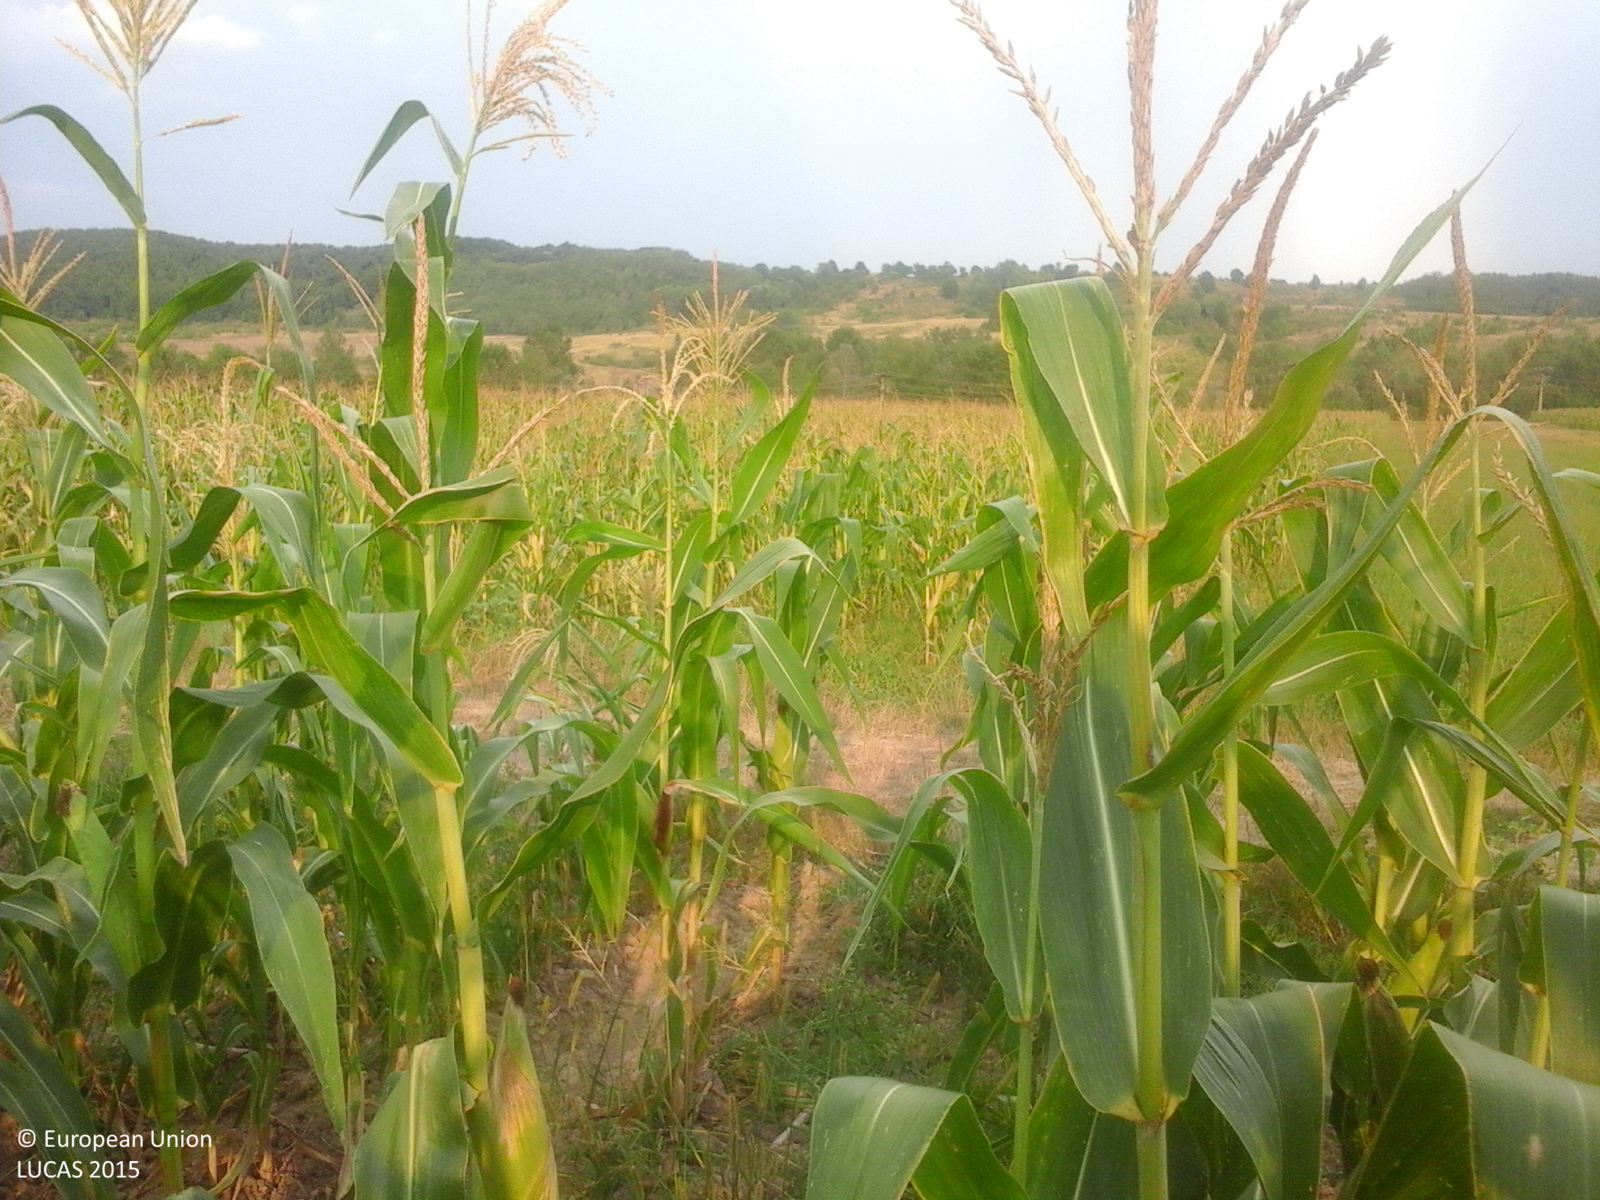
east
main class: Cropland
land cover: Maize
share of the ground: > 75 %
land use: Agriculture (excluding fallow land and kitchen gardens)
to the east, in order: Maize; Grass margins; Tracks; Grass margins; Lucerne; Maize; Common wheat; Maize
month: August
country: RO
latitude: 44.7606
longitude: 23.6386
